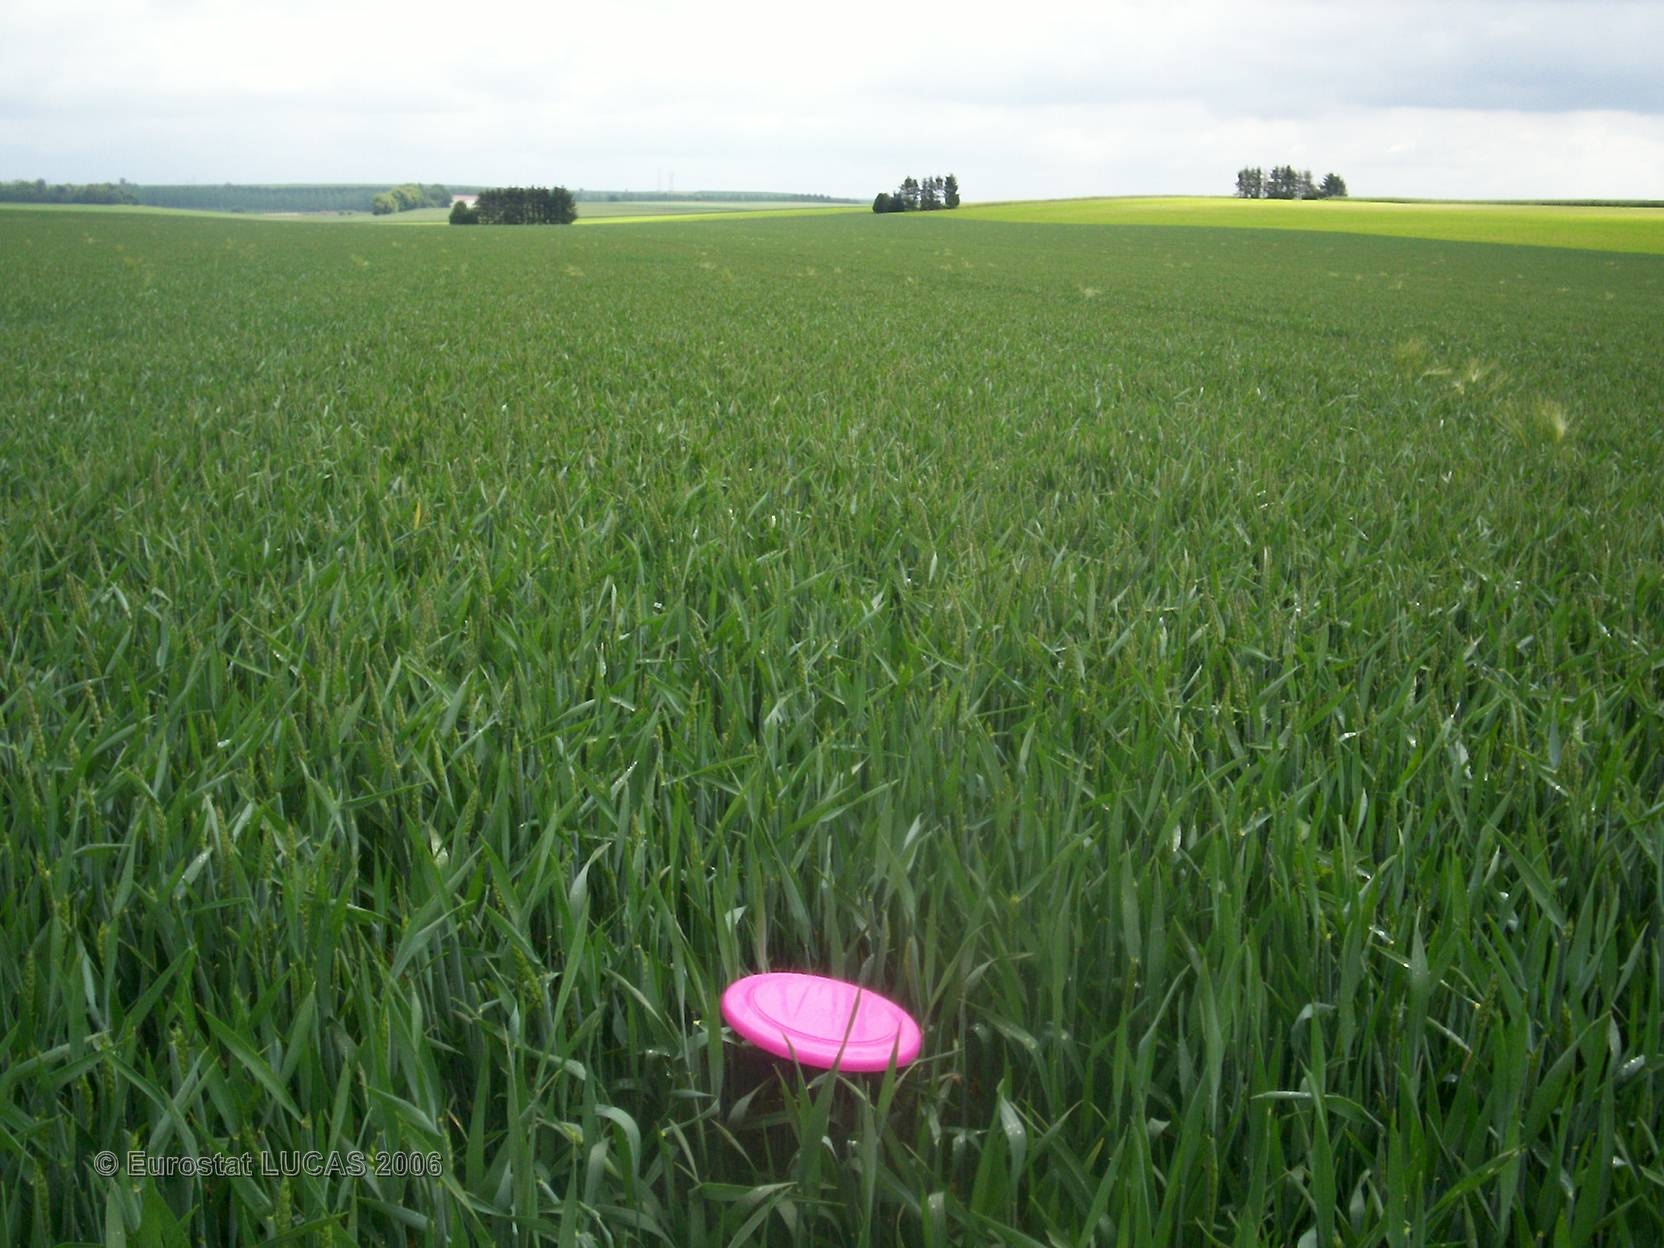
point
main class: Cropland
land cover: Common wheat
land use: Agriculture (excluding fallow land and kitchen gardens)
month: June
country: FR
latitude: 48.5902
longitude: 4.4790
